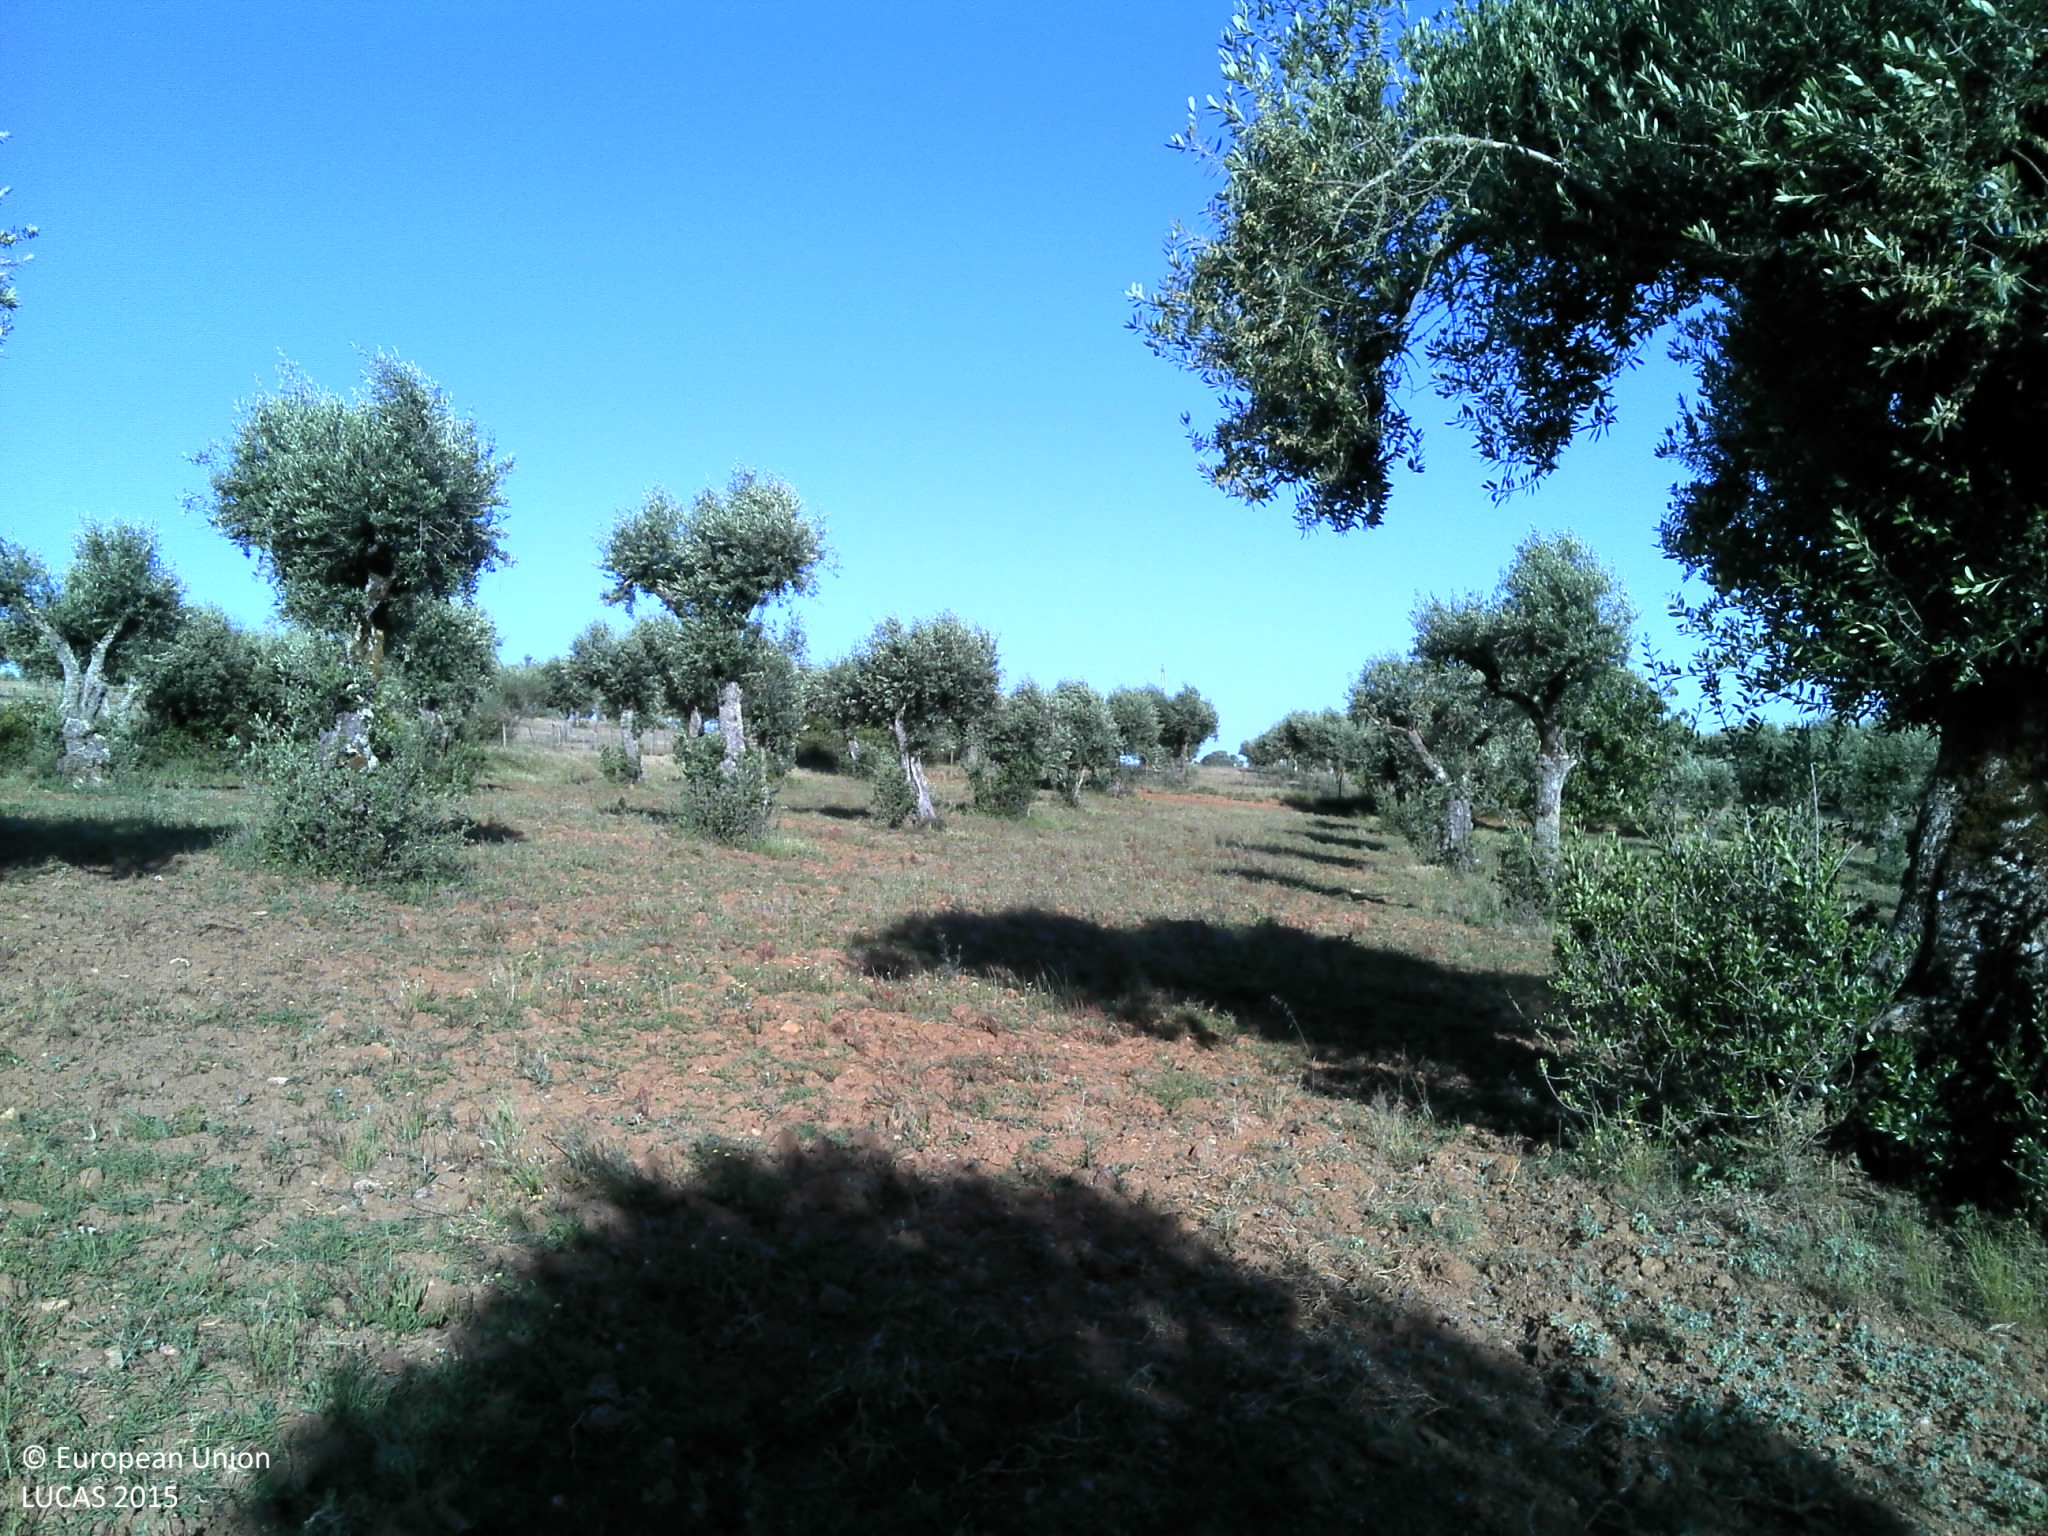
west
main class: Cropland
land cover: Olive groves
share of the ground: 10 - 25 %
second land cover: Grassland without tree/shrub cover
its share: 10 - 25 %
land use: Agriculture (excluding fallow land and kitchen gardens)
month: May
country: PT
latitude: 39.1638
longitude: -7.9797
